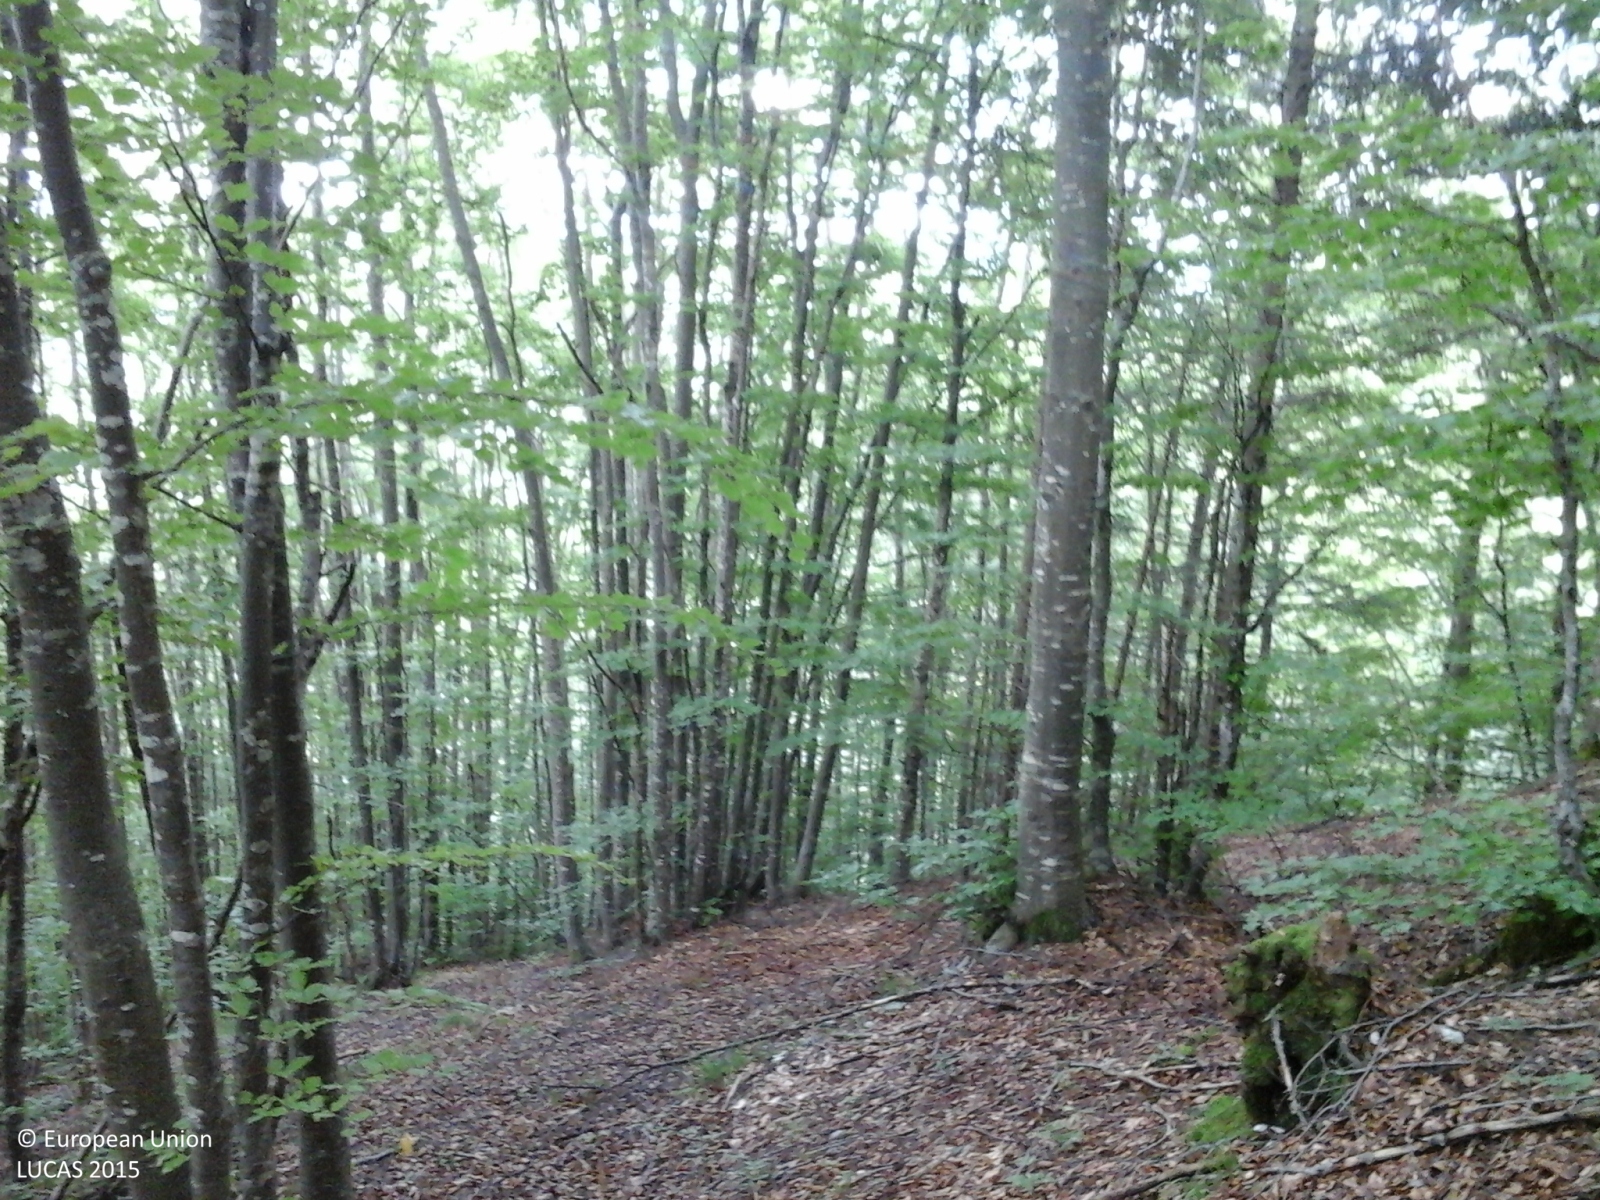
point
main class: Woodland
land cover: Broadleaved woodland
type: mountainous beech forest
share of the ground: > 75 %
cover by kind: broadleaved forest trees 100 %
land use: Forestry
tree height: > 5 m
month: June
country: IT
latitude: 45.8706
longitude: 11.6080
